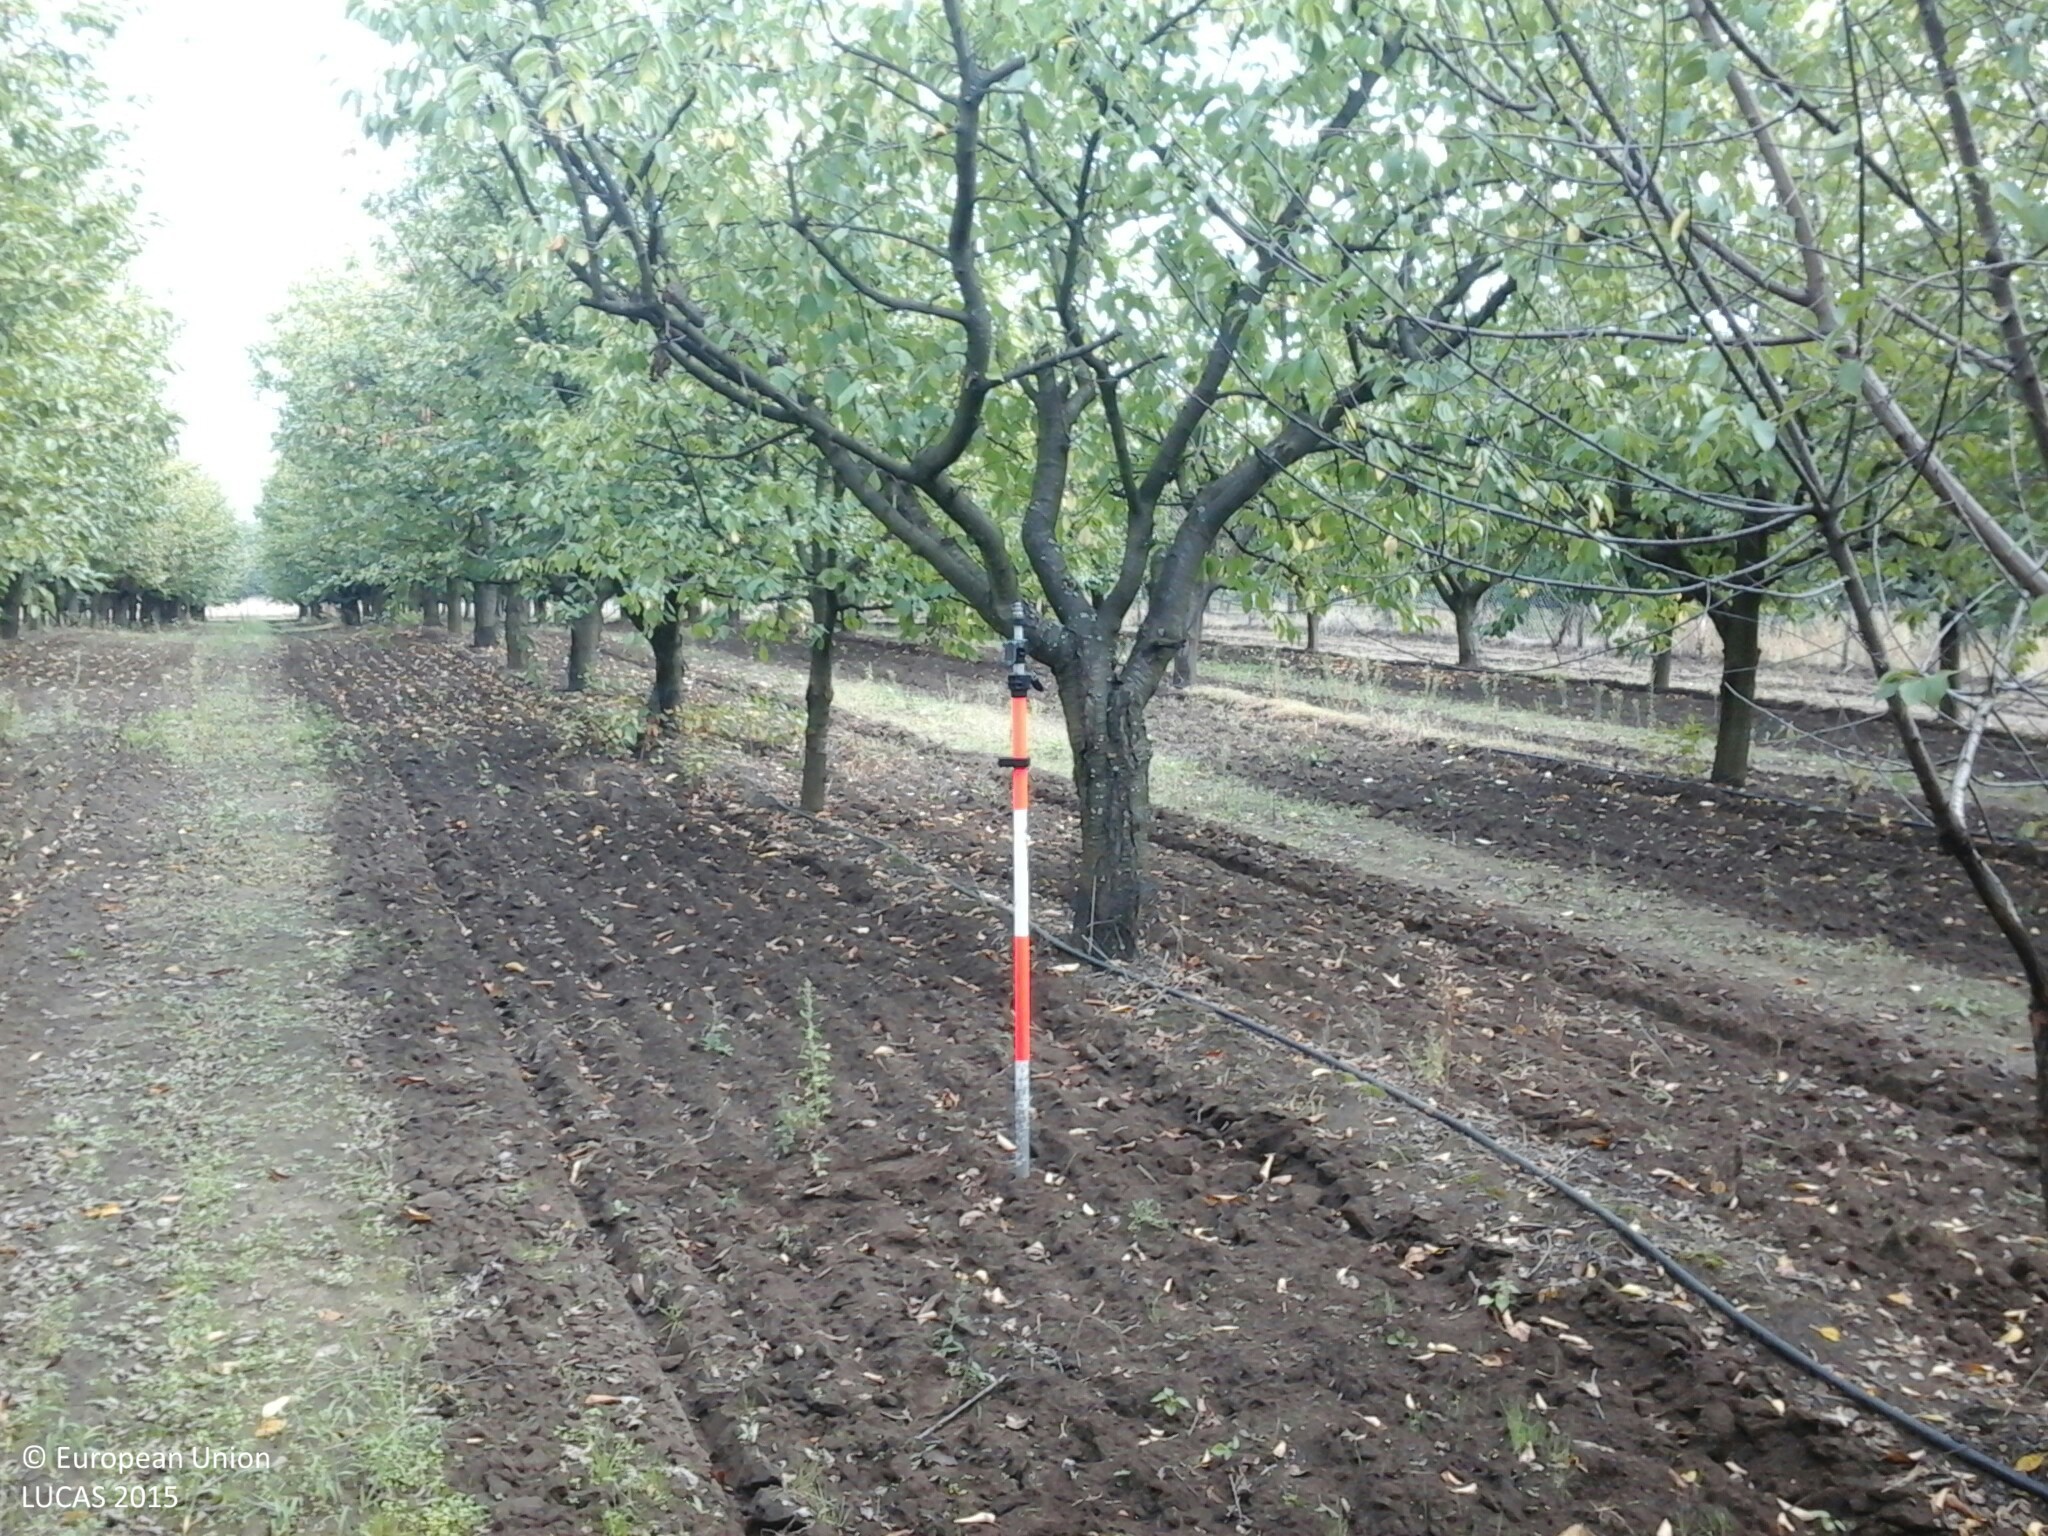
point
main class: Cropland
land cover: Cherry fruit
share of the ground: 50 - 75 %
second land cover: Other bare soil
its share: > 75 %
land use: Agriculture (excluding fallow land and kitchen gardens)
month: September
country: HU
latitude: 47.6650
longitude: 20.3238
